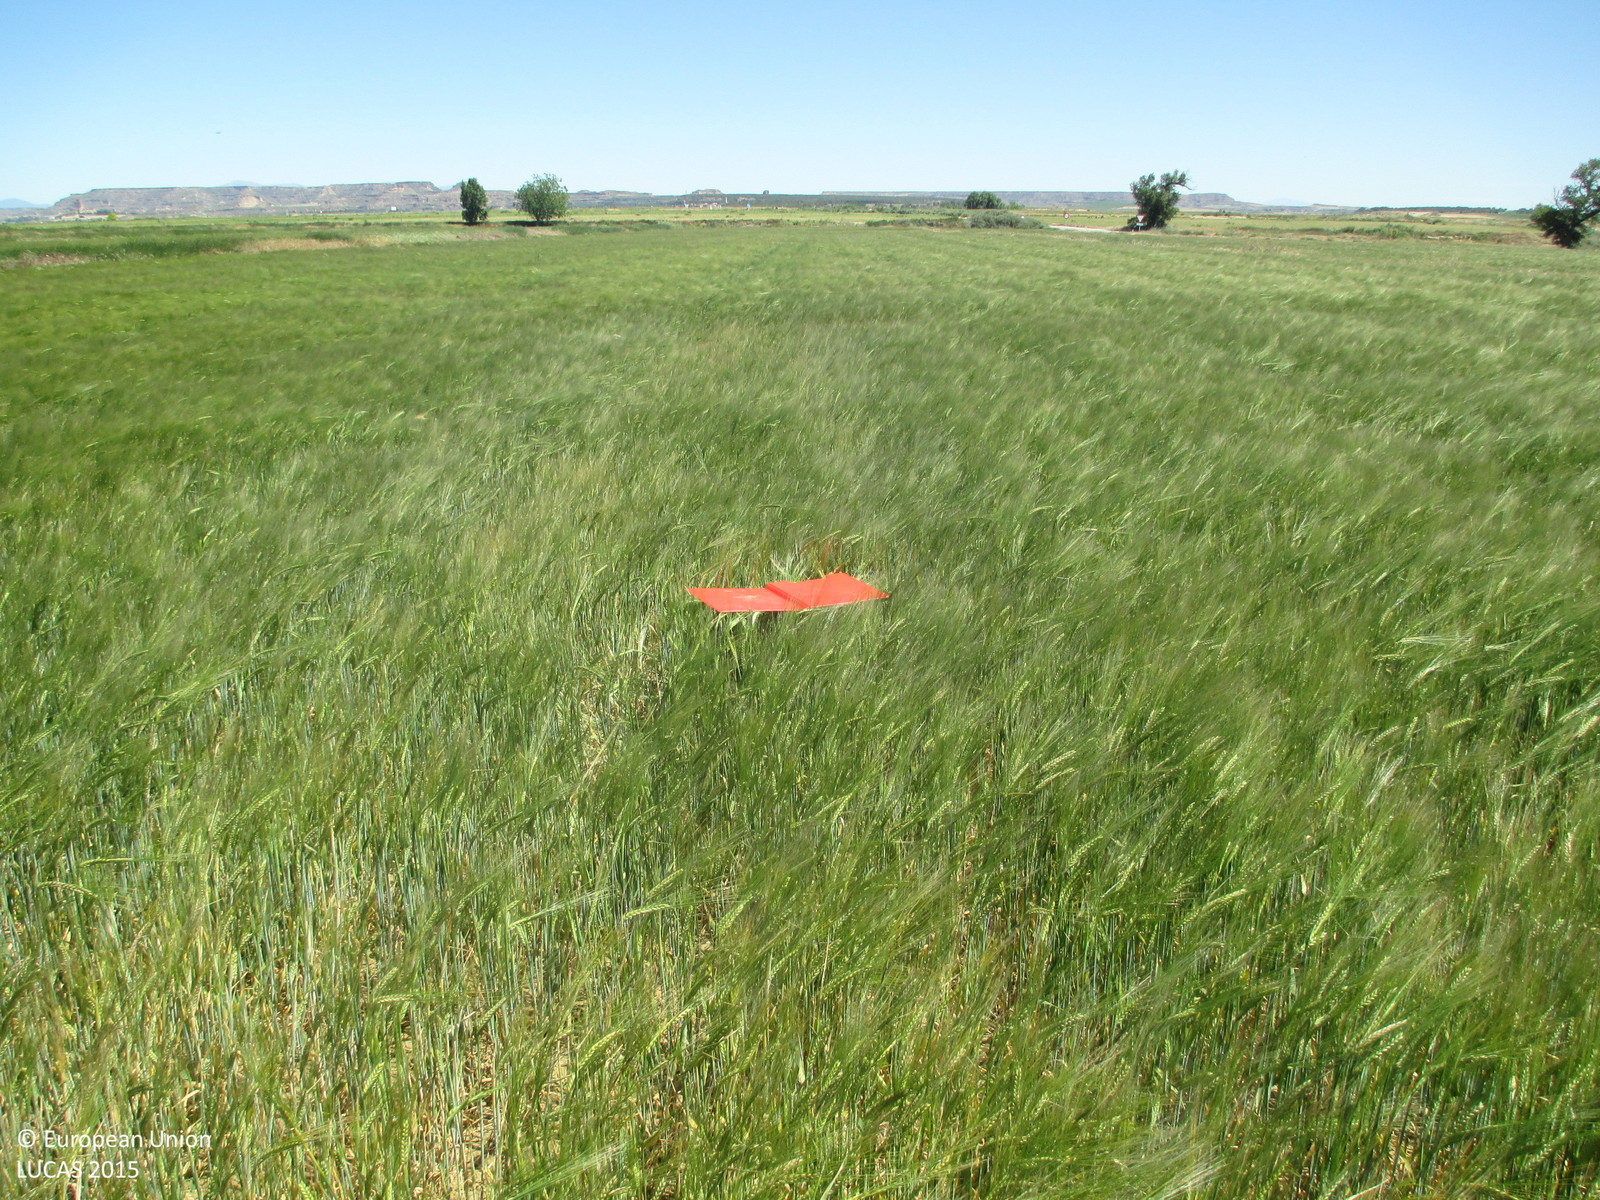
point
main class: Cropland
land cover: Barley
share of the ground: > 75 %
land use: Agriculture (excluding fallow land and kitchen gardens)
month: May
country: ES
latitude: 41.8577
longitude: -0.2704
